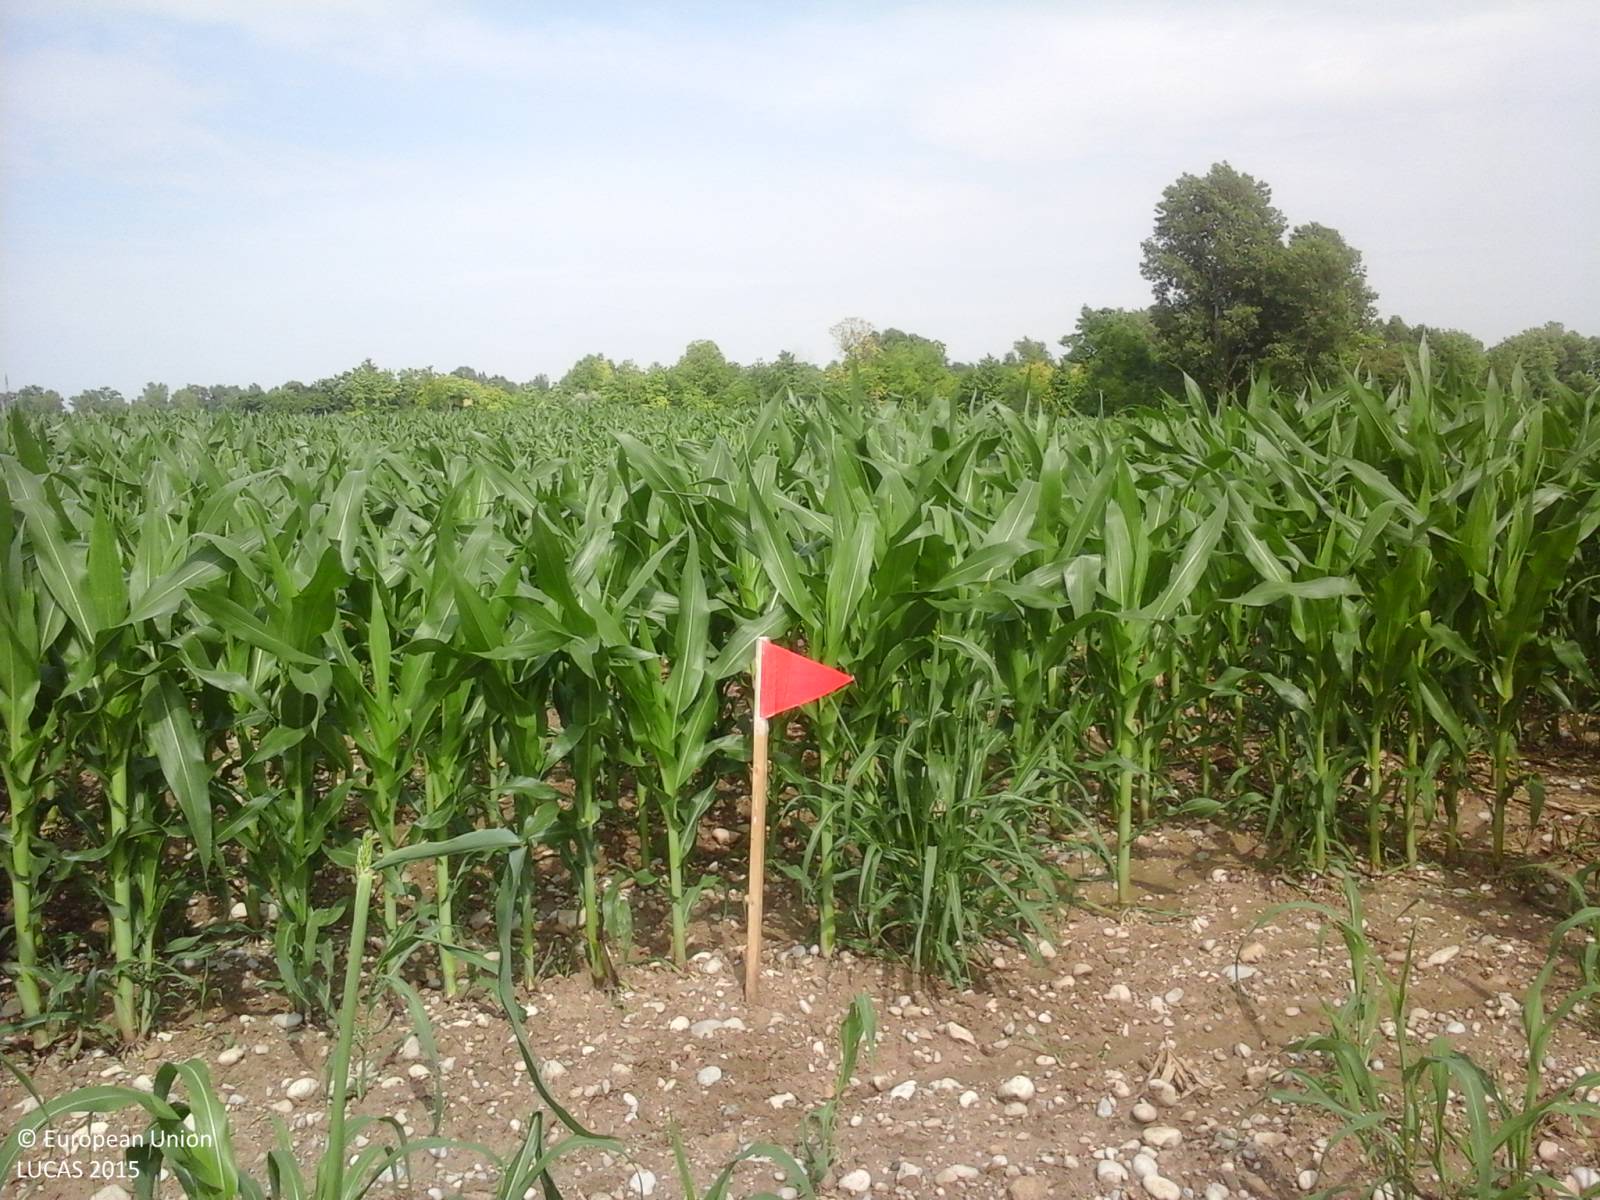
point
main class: Cropland
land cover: Maize
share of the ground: > 75 %
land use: Agriculture (excluding fallow land and kitchen gardens)
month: June
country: IT
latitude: 46.0102
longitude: 12.7217
